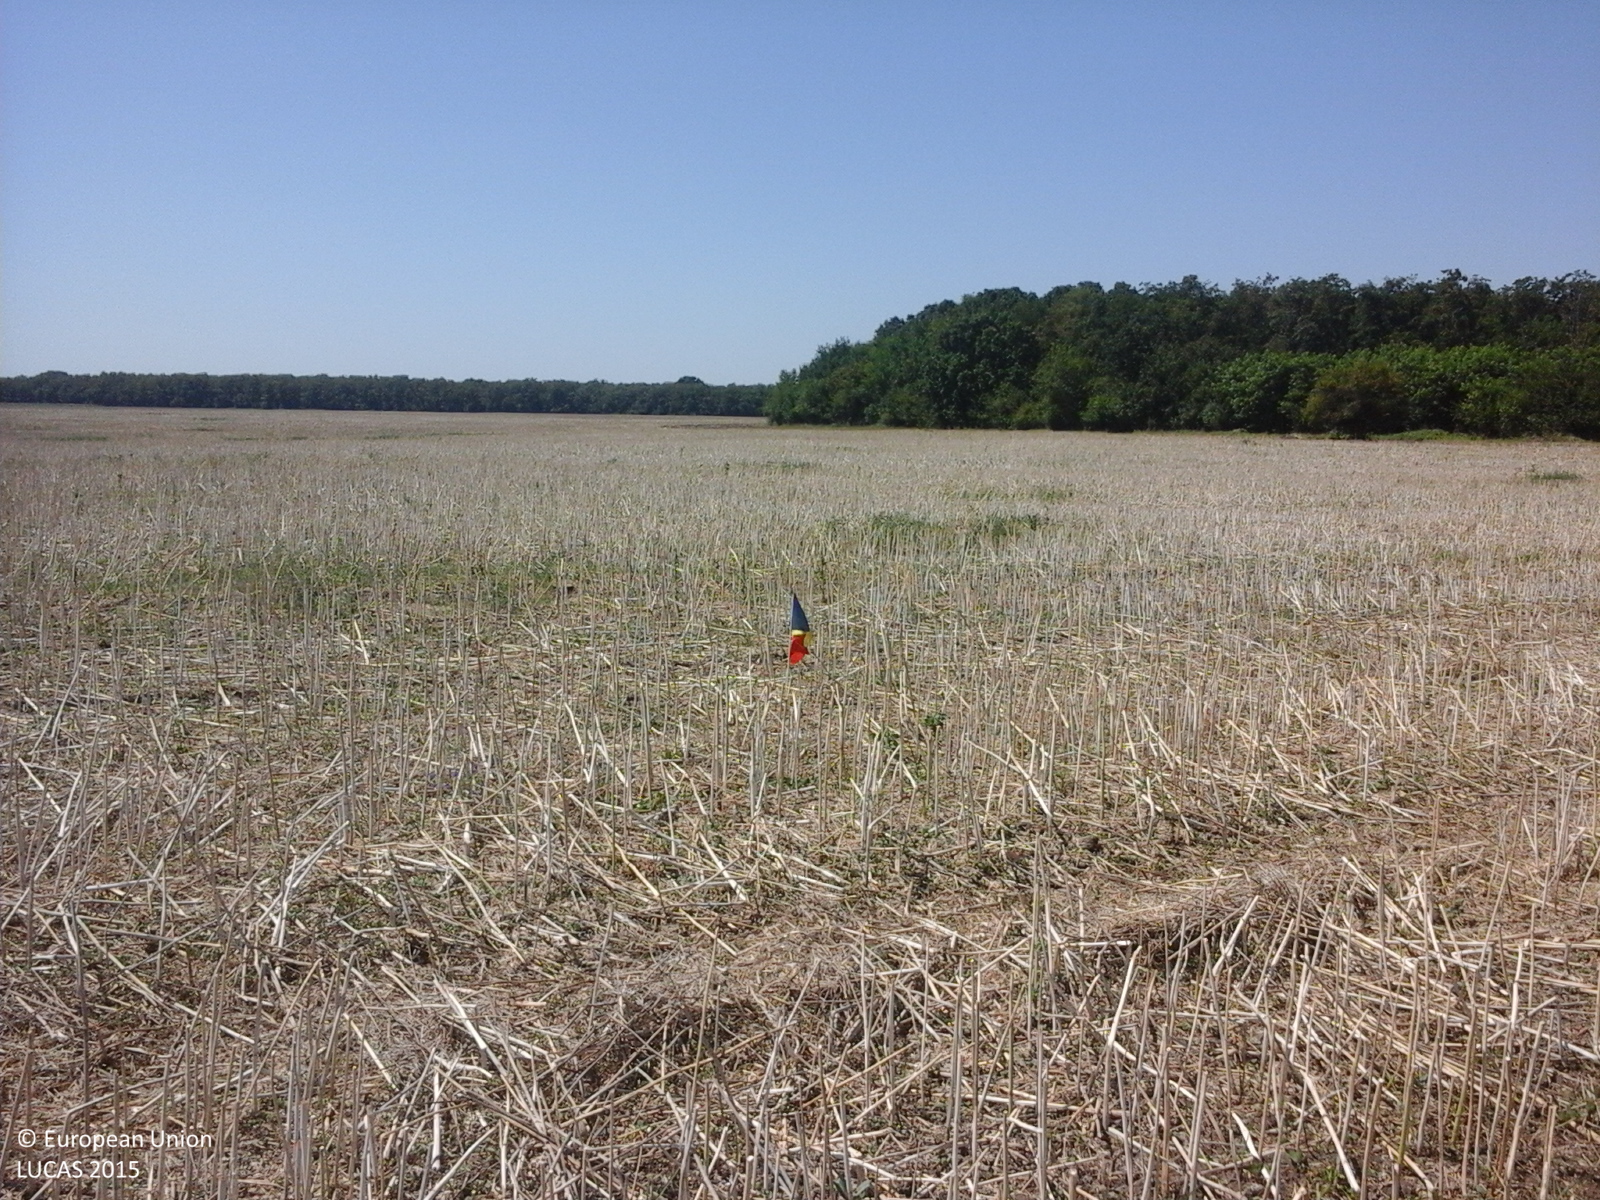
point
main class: Cropland
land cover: Rape and turnip rape
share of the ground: 10 - 25 %
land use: Agriculture (excluding fallow land and kitchen gardens)
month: July
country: RO
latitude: 44.3088
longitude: 26.7041
